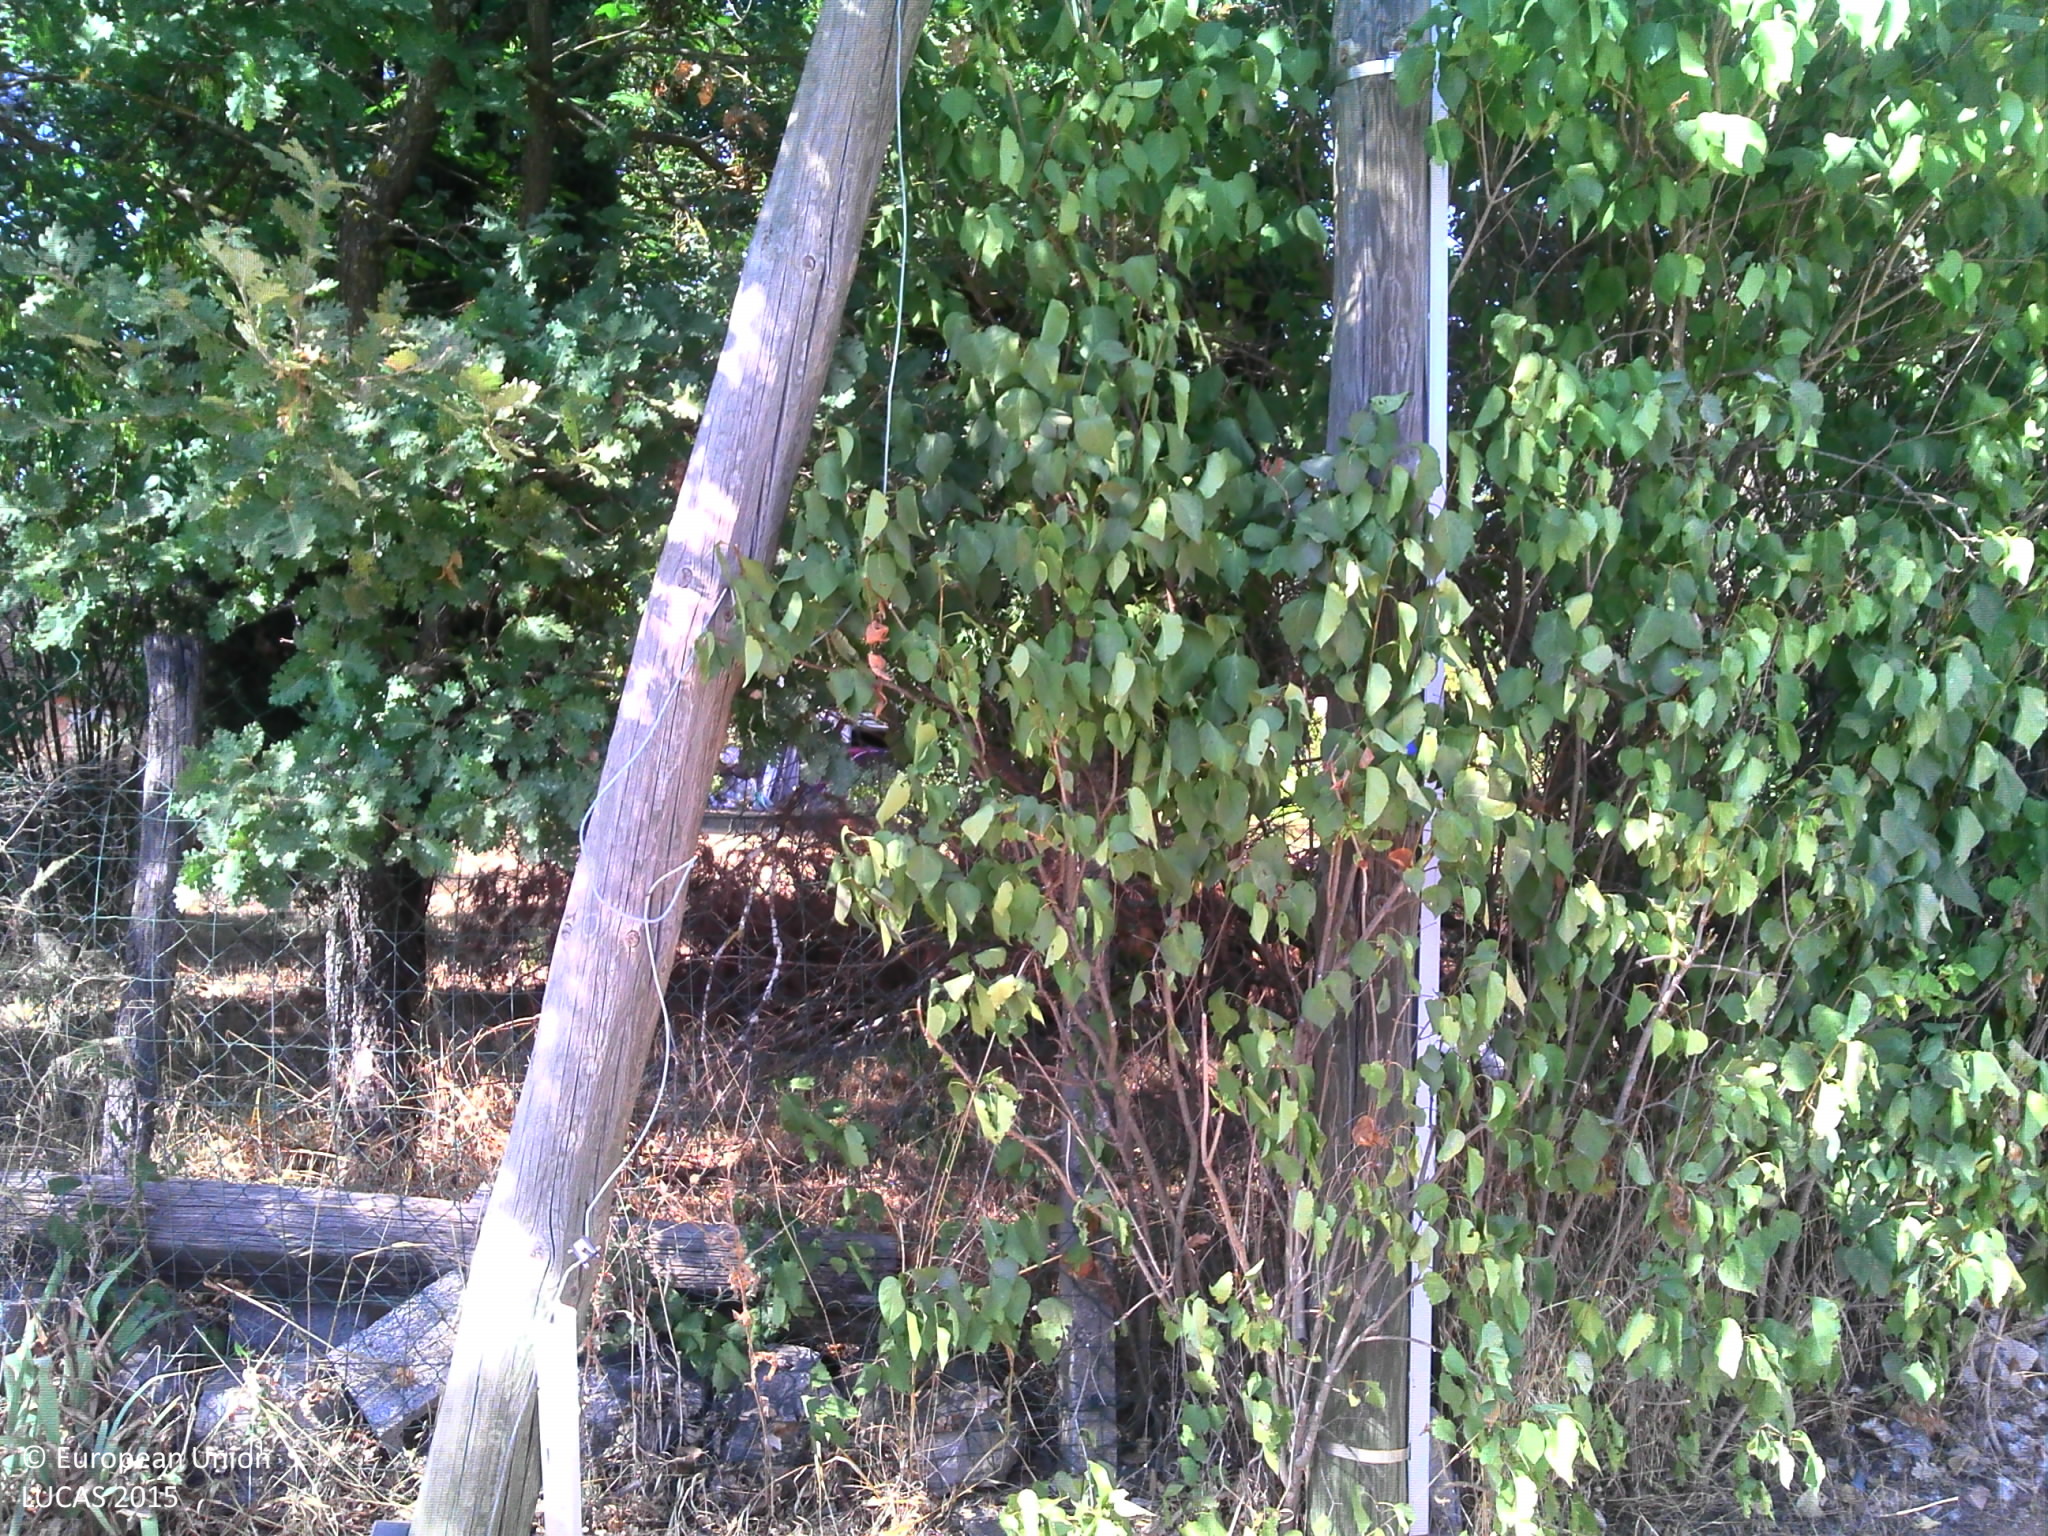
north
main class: Woodland
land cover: Broadleaved woodland
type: thermophilous deciduous forest
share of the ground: > 75 %
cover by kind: broadleaved forest trees 70 %, herbaceous plants 25 %, unconsolidated bare surface 5 %
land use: Residential
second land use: Forestry
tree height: > 5 m
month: August
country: FR
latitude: 43.3902
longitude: 5.6027
